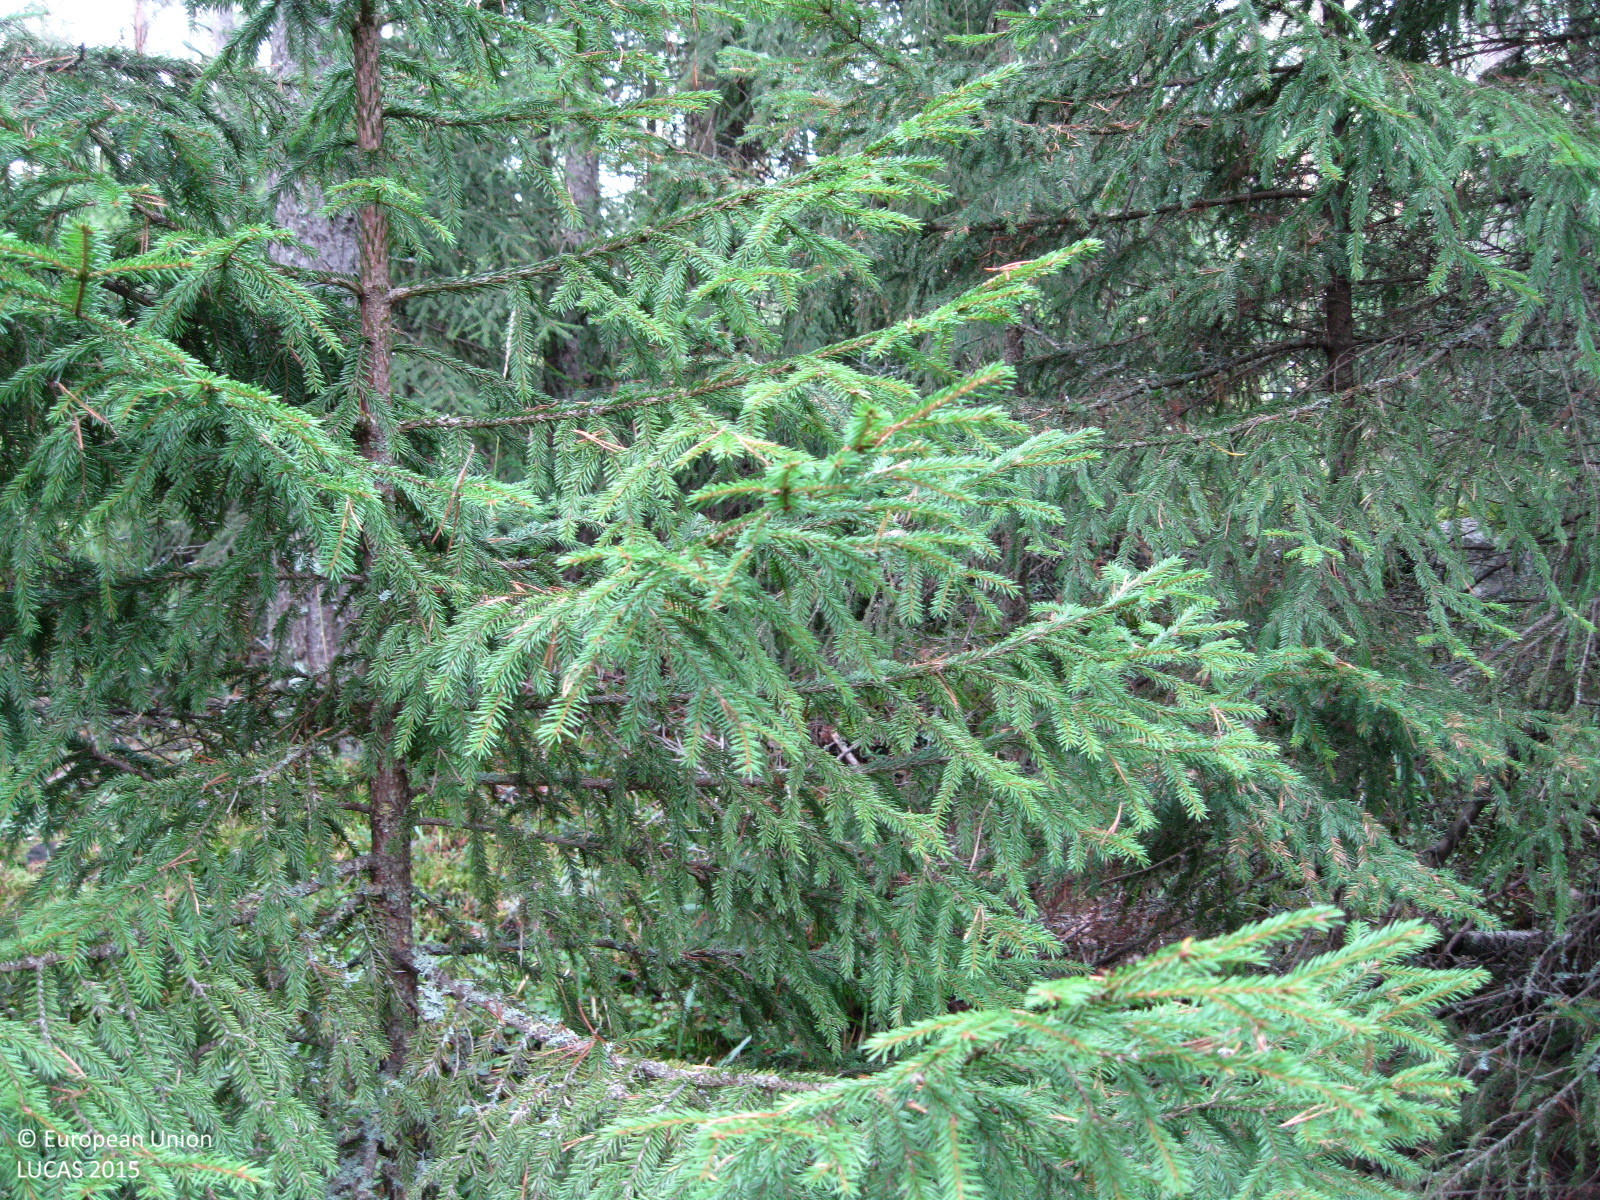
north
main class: Woodland
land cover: Other coniferous woodland
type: boreal forest
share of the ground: 50 - 75 %
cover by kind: coniferous forest trees 60 %, shrubs 15 %, broadleaved forest trees 10 %, lichens and mosses 10 %, herbaceous plants 5 %
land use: Forestry
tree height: > 5 m
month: September
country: FI
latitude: 60.5454
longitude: 24.6764
